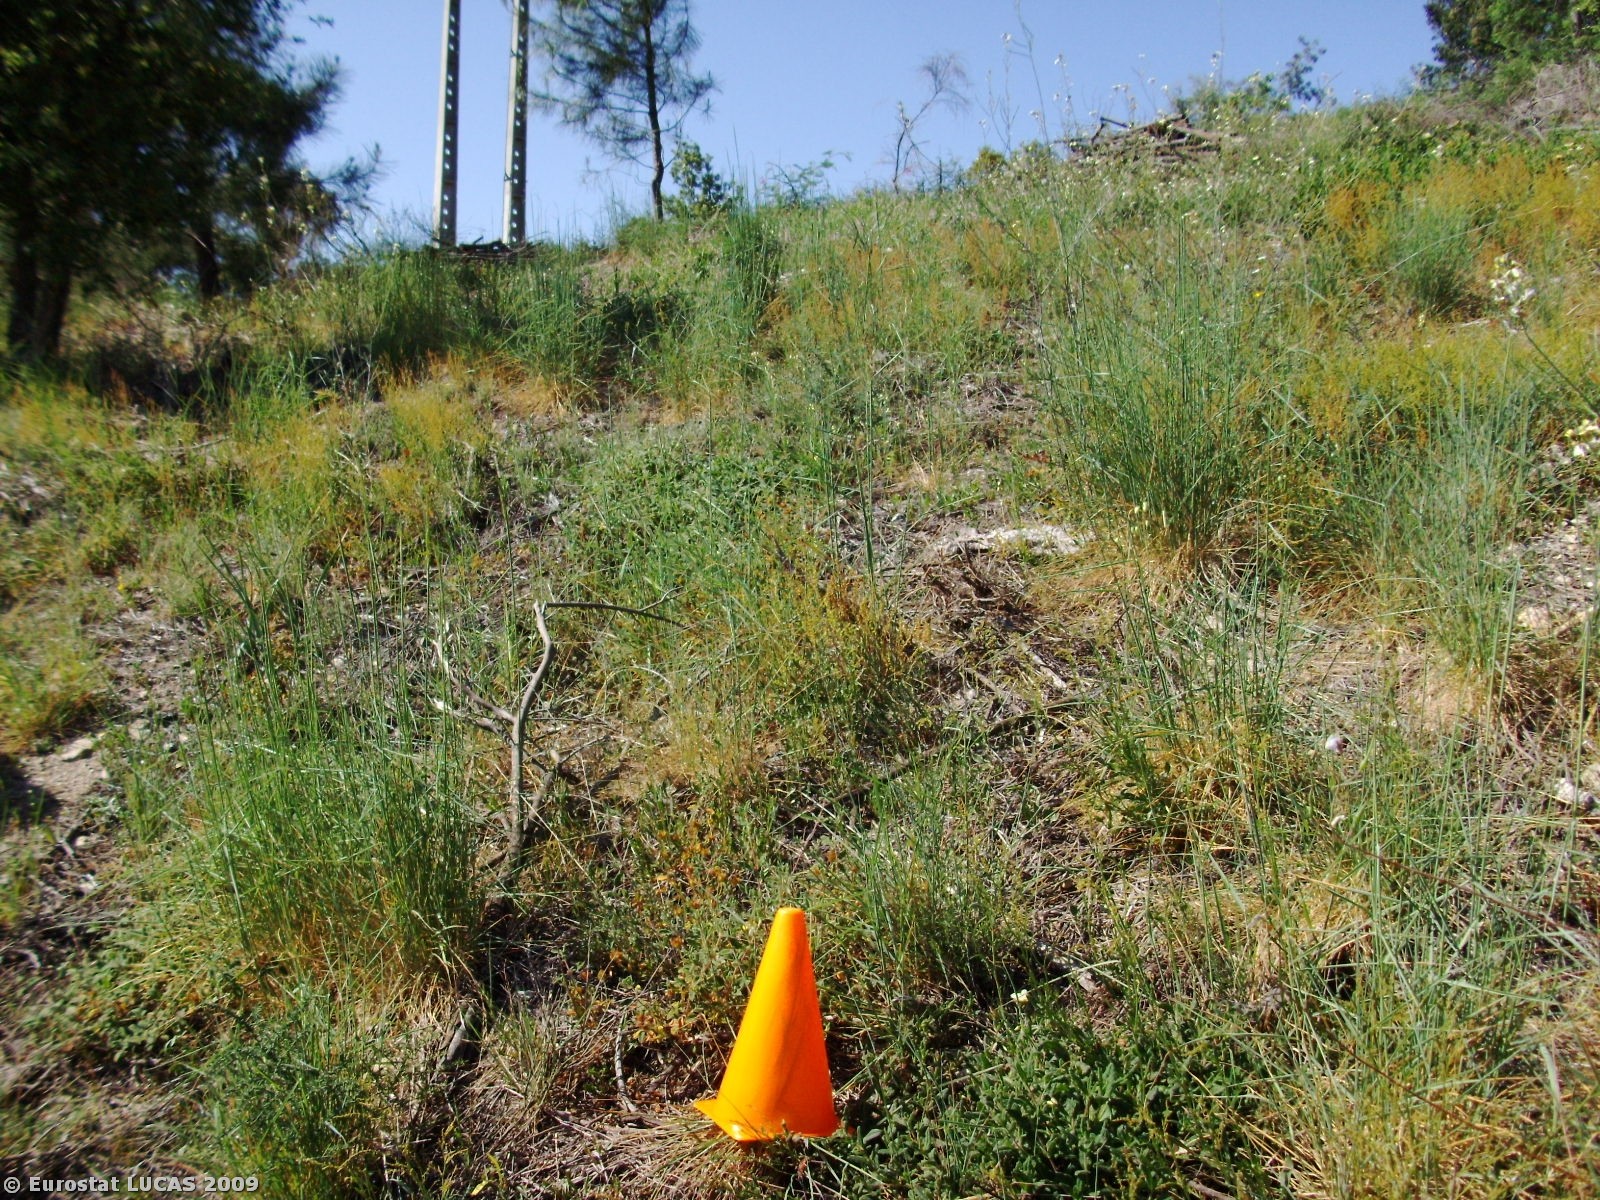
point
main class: Grassland
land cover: Grassland with sparse tree/shrub cover
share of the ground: 50 - 75 %
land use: Forestry
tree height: > 5 m
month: May
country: PT
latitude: 39.3036
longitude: -7.4245
